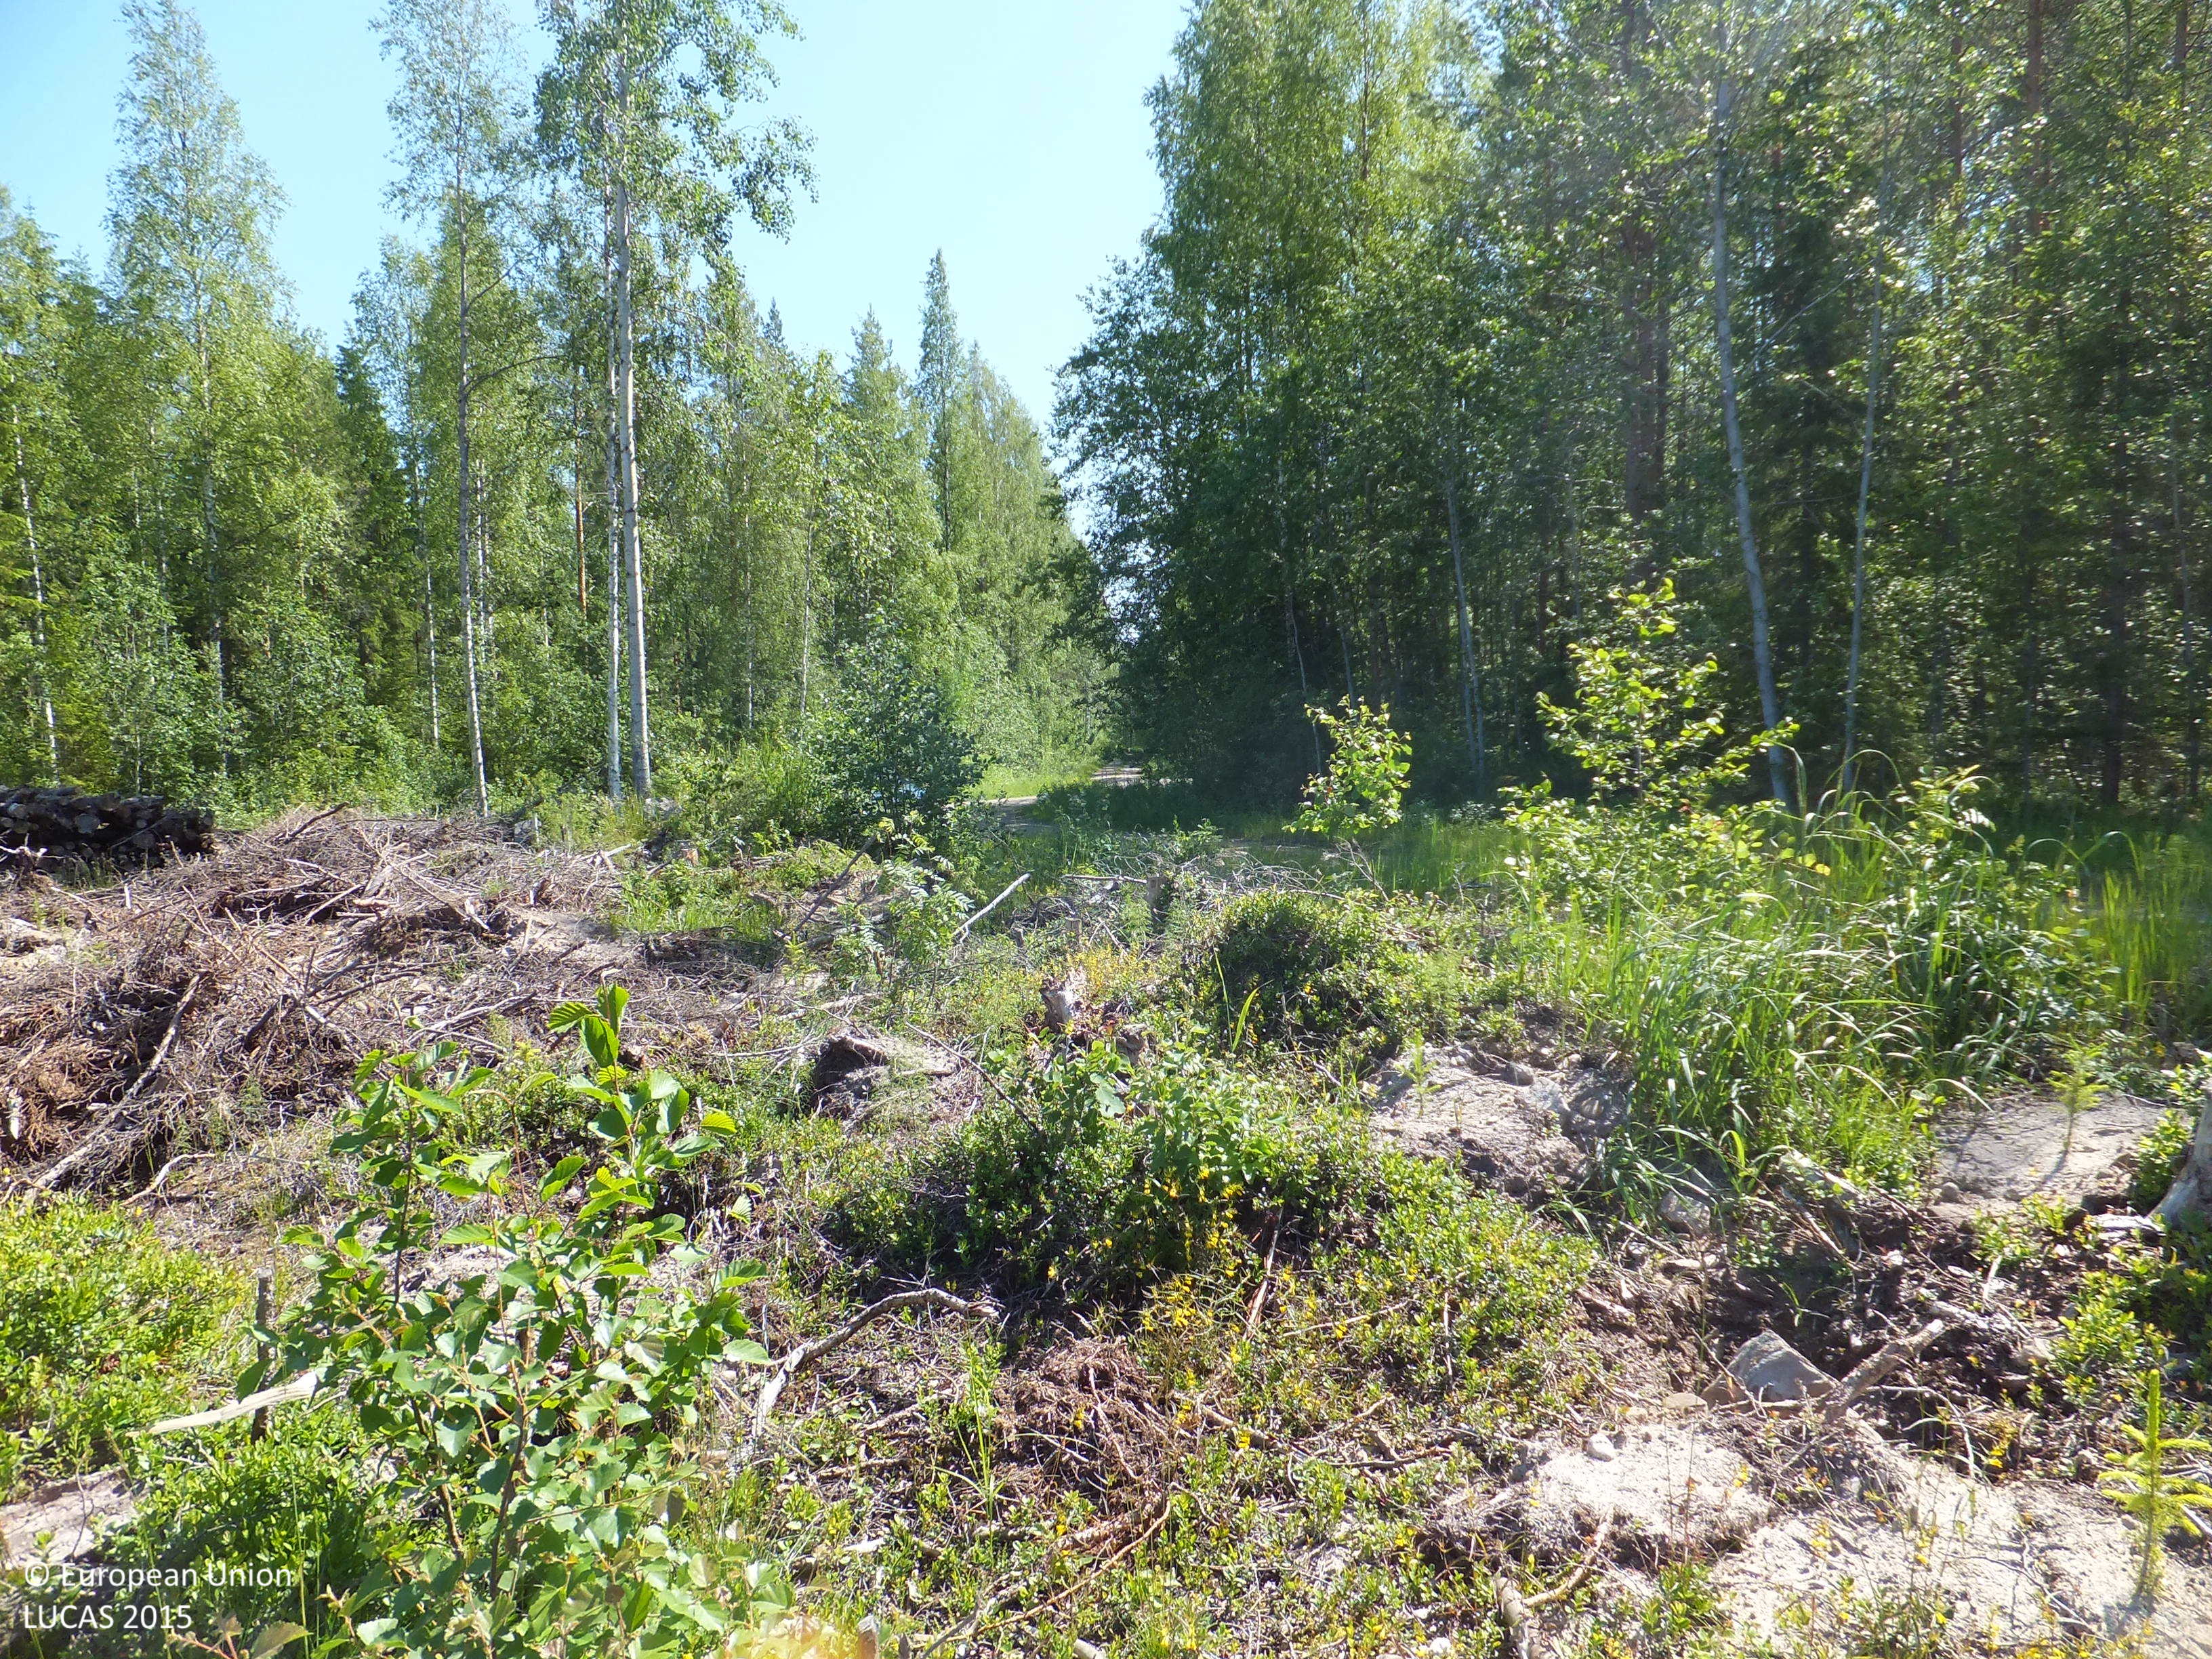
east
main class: Shrubland
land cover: Shrubland without tree cover
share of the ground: 50 - 75 %
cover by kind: shrubs 30 %, unconsolidated bare surface 30 %, herbaceous plants 10 %, consolidated bare surface 10 %
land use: Forestry
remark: Clear cut
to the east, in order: Shrubland without tree cover; Broadleaved woodland; Spontaneously vegetated surfaces; Paved roads, cycling and walking lanes; Grass margins; Ditches and canals; Other mixed woodland; Ditches and canals; Other mixed woodland; Ditches and canals; Pine dominated mixed woodland
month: July
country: FI
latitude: 63.1352
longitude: 24.1400
